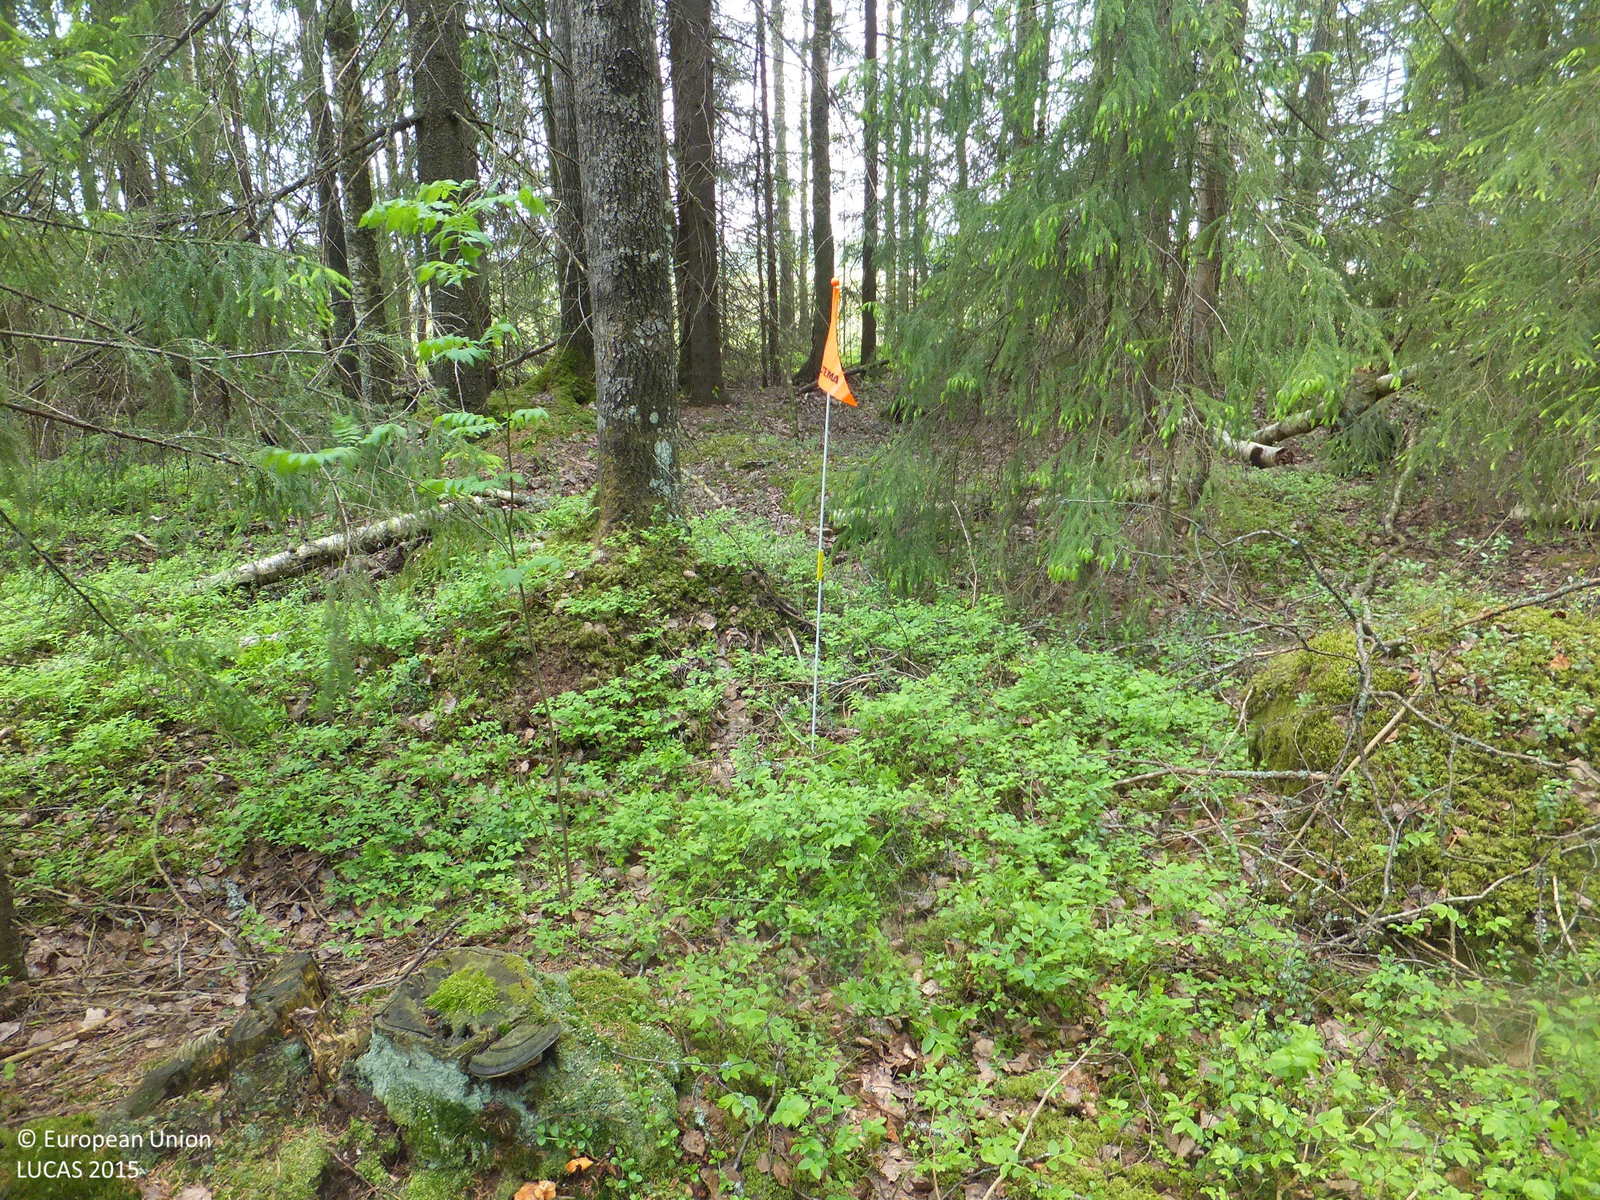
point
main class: Woodland
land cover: Spruce dominated mixed woodland
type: boreal forest
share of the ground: > 75 %
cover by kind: coniferous forest trees 55 %, broadleaved forest trees 20 %, shrubs 10 %, lichens and mosses 10 %, herbaceous plants 5 %
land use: Forestry
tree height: > 5 m
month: June
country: FI
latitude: 63.1866
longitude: 22.5089
